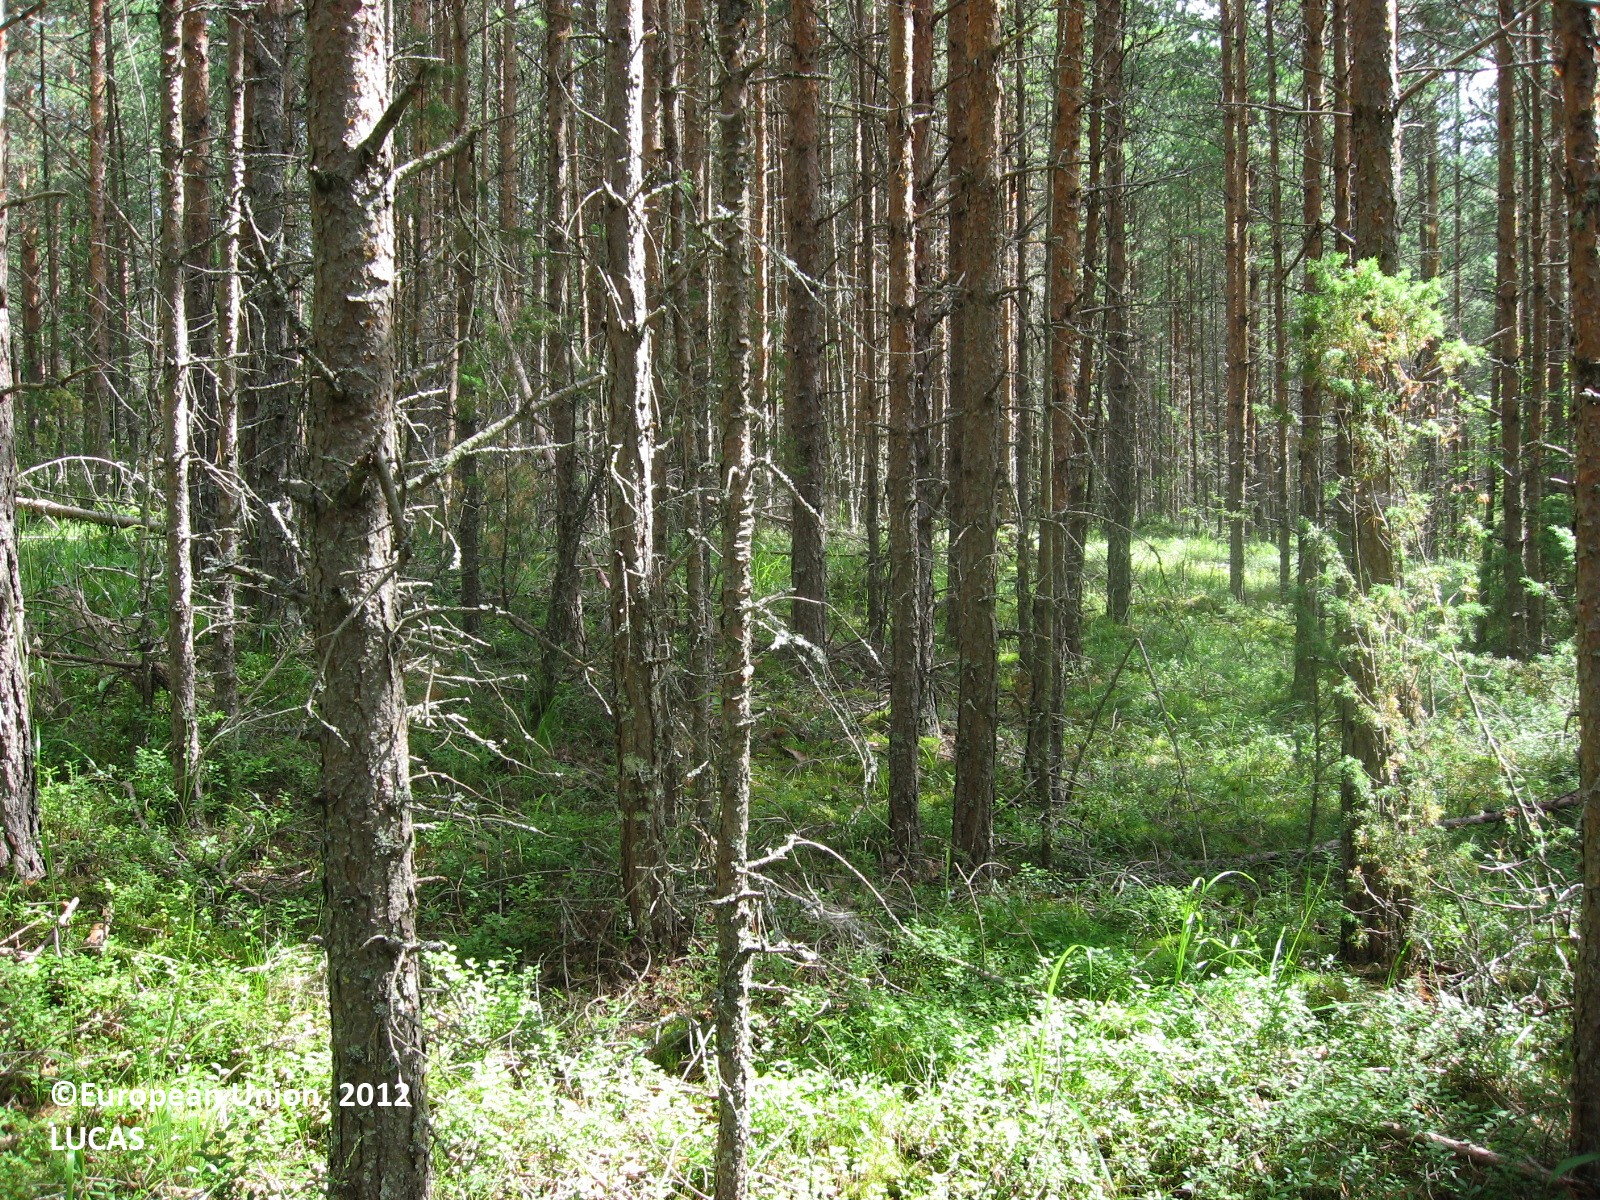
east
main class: Woodland
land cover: Pine dominated coniferous woodland
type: boreal forest
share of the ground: > 75 %
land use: Forestry
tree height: > 5 m
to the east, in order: Pine dominated coniferous woodland; Tracks; Pine dominated coniferous woodland
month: July
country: FI
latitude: 61.1223
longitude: 25.8174
